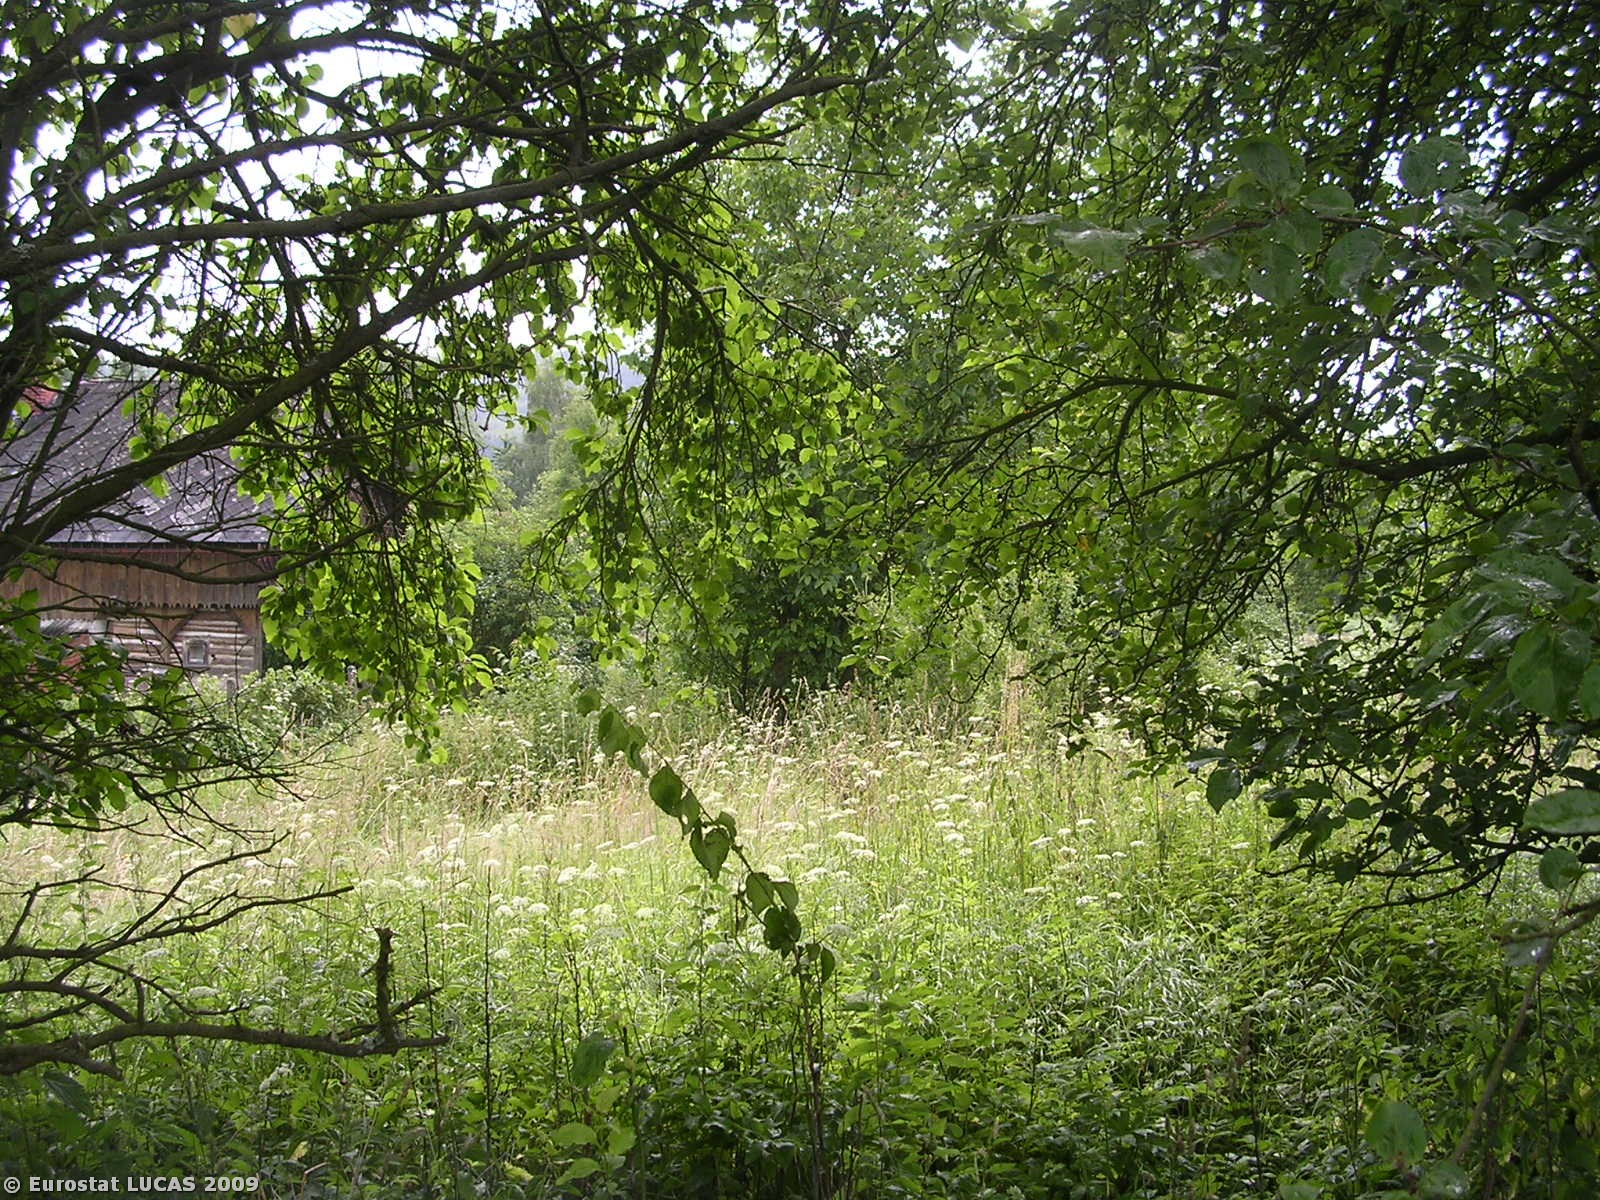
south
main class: Cropland
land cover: Other fruit trees and berries
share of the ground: 25 - 50 %
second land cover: Grassland with sparse tree/shrub cover
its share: > 75 %
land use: Kitchen garden
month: July
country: CZ
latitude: 50.6488
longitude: 15.0520
